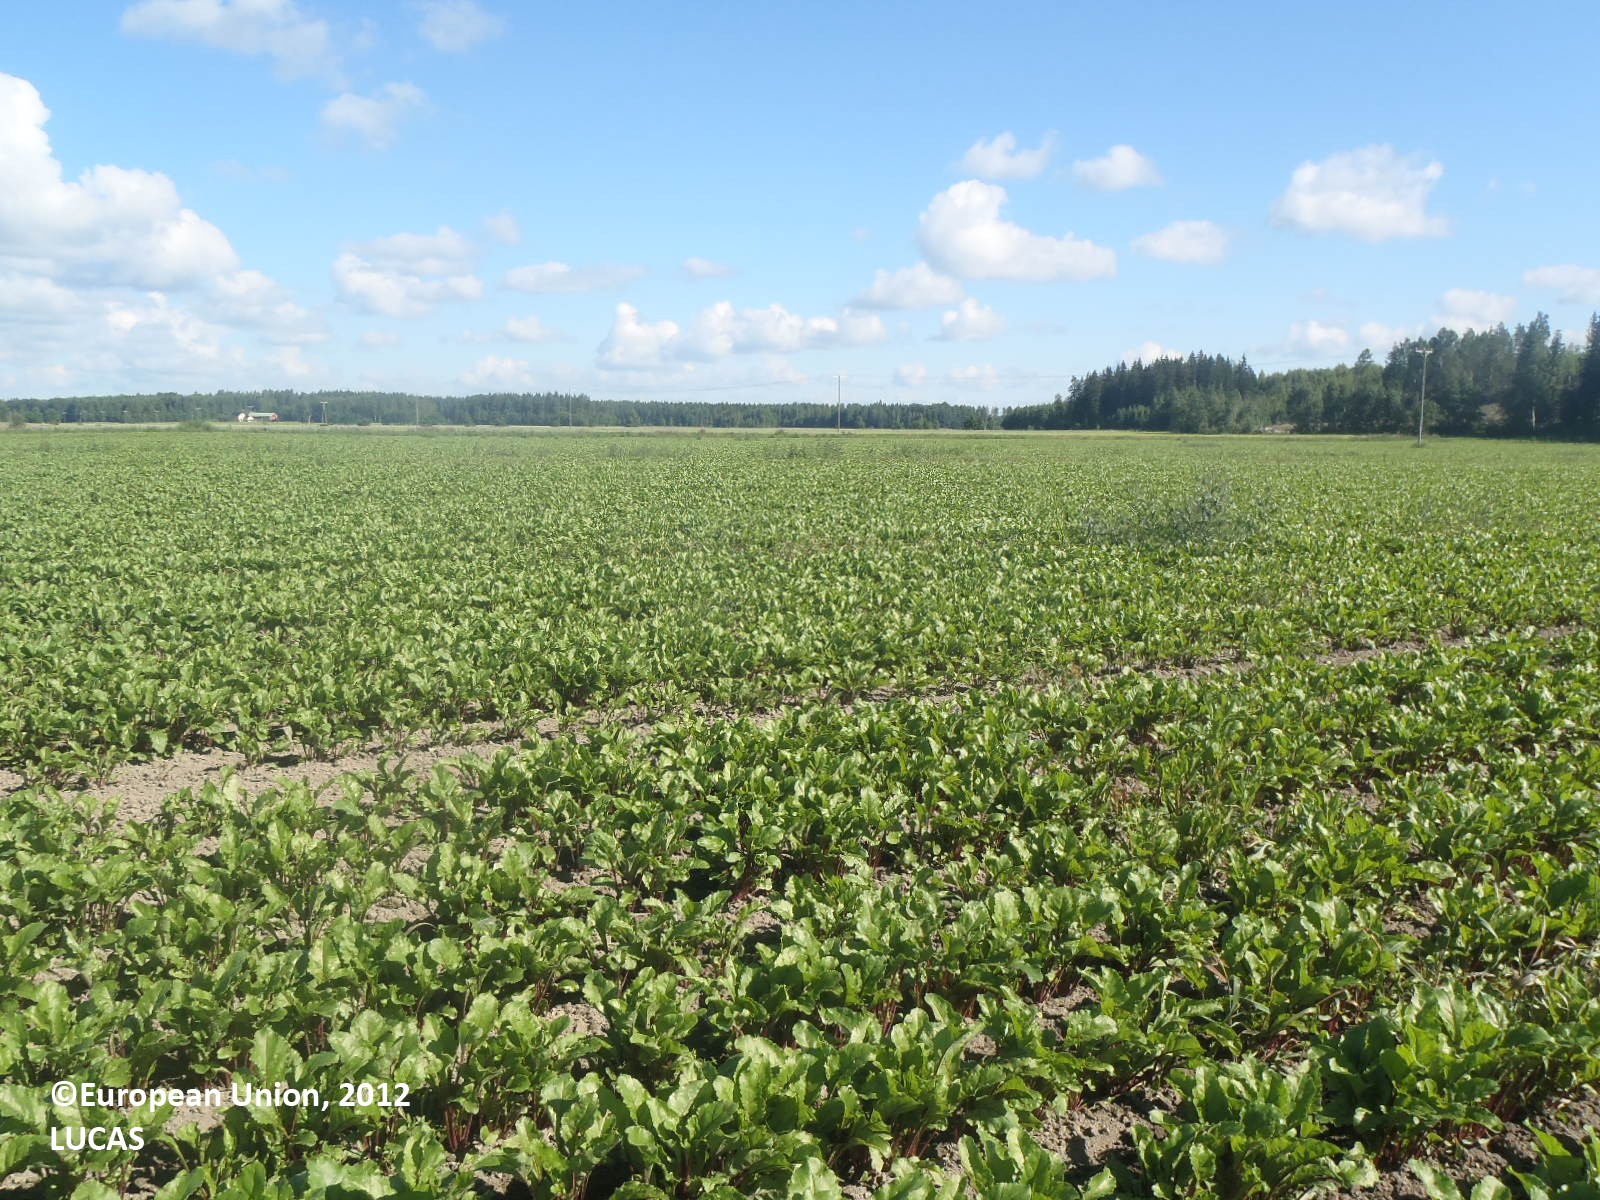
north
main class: Cropland
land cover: Other root crops
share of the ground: 50 - 75 %
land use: Agriculture (excluding fallow land and kitchen gardens)
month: July
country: FI
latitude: 61.0024
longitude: 21.9498
